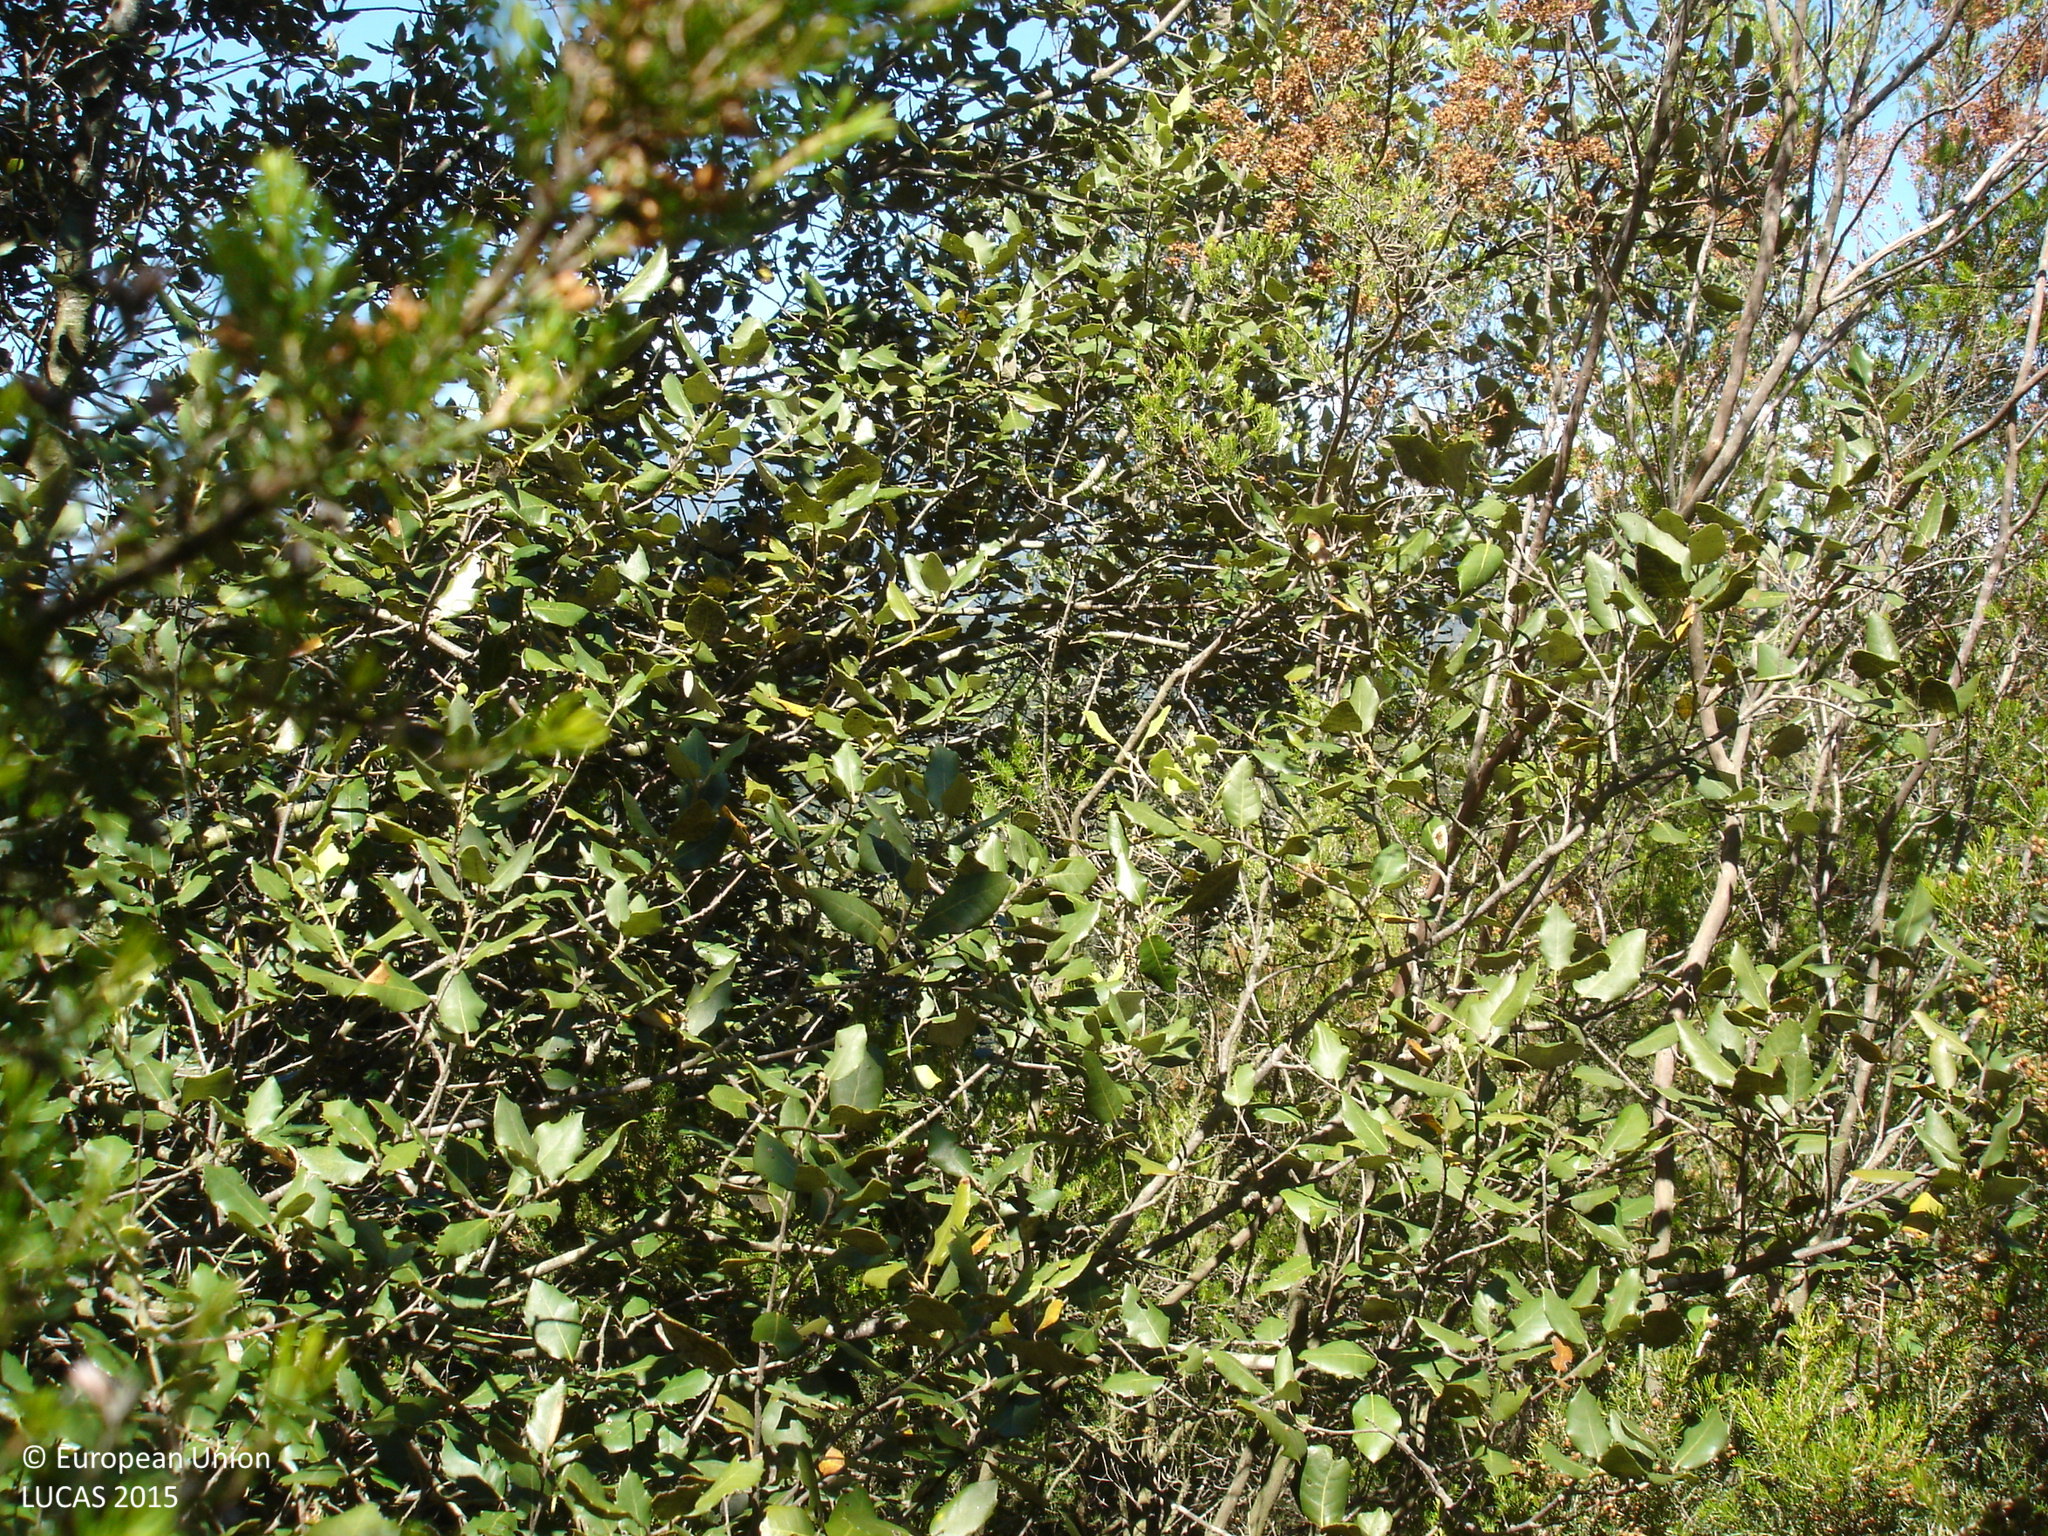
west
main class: Woodland
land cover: Broadleaved woodland
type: thermophilous deciduous forest
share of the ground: > 75 %
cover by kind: broadleaved forest trees 75 %, herbaceous plants 25 %
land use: Forestry
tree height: > 5 m
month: June
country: ES
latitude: 41.7662
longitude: 2.5947
